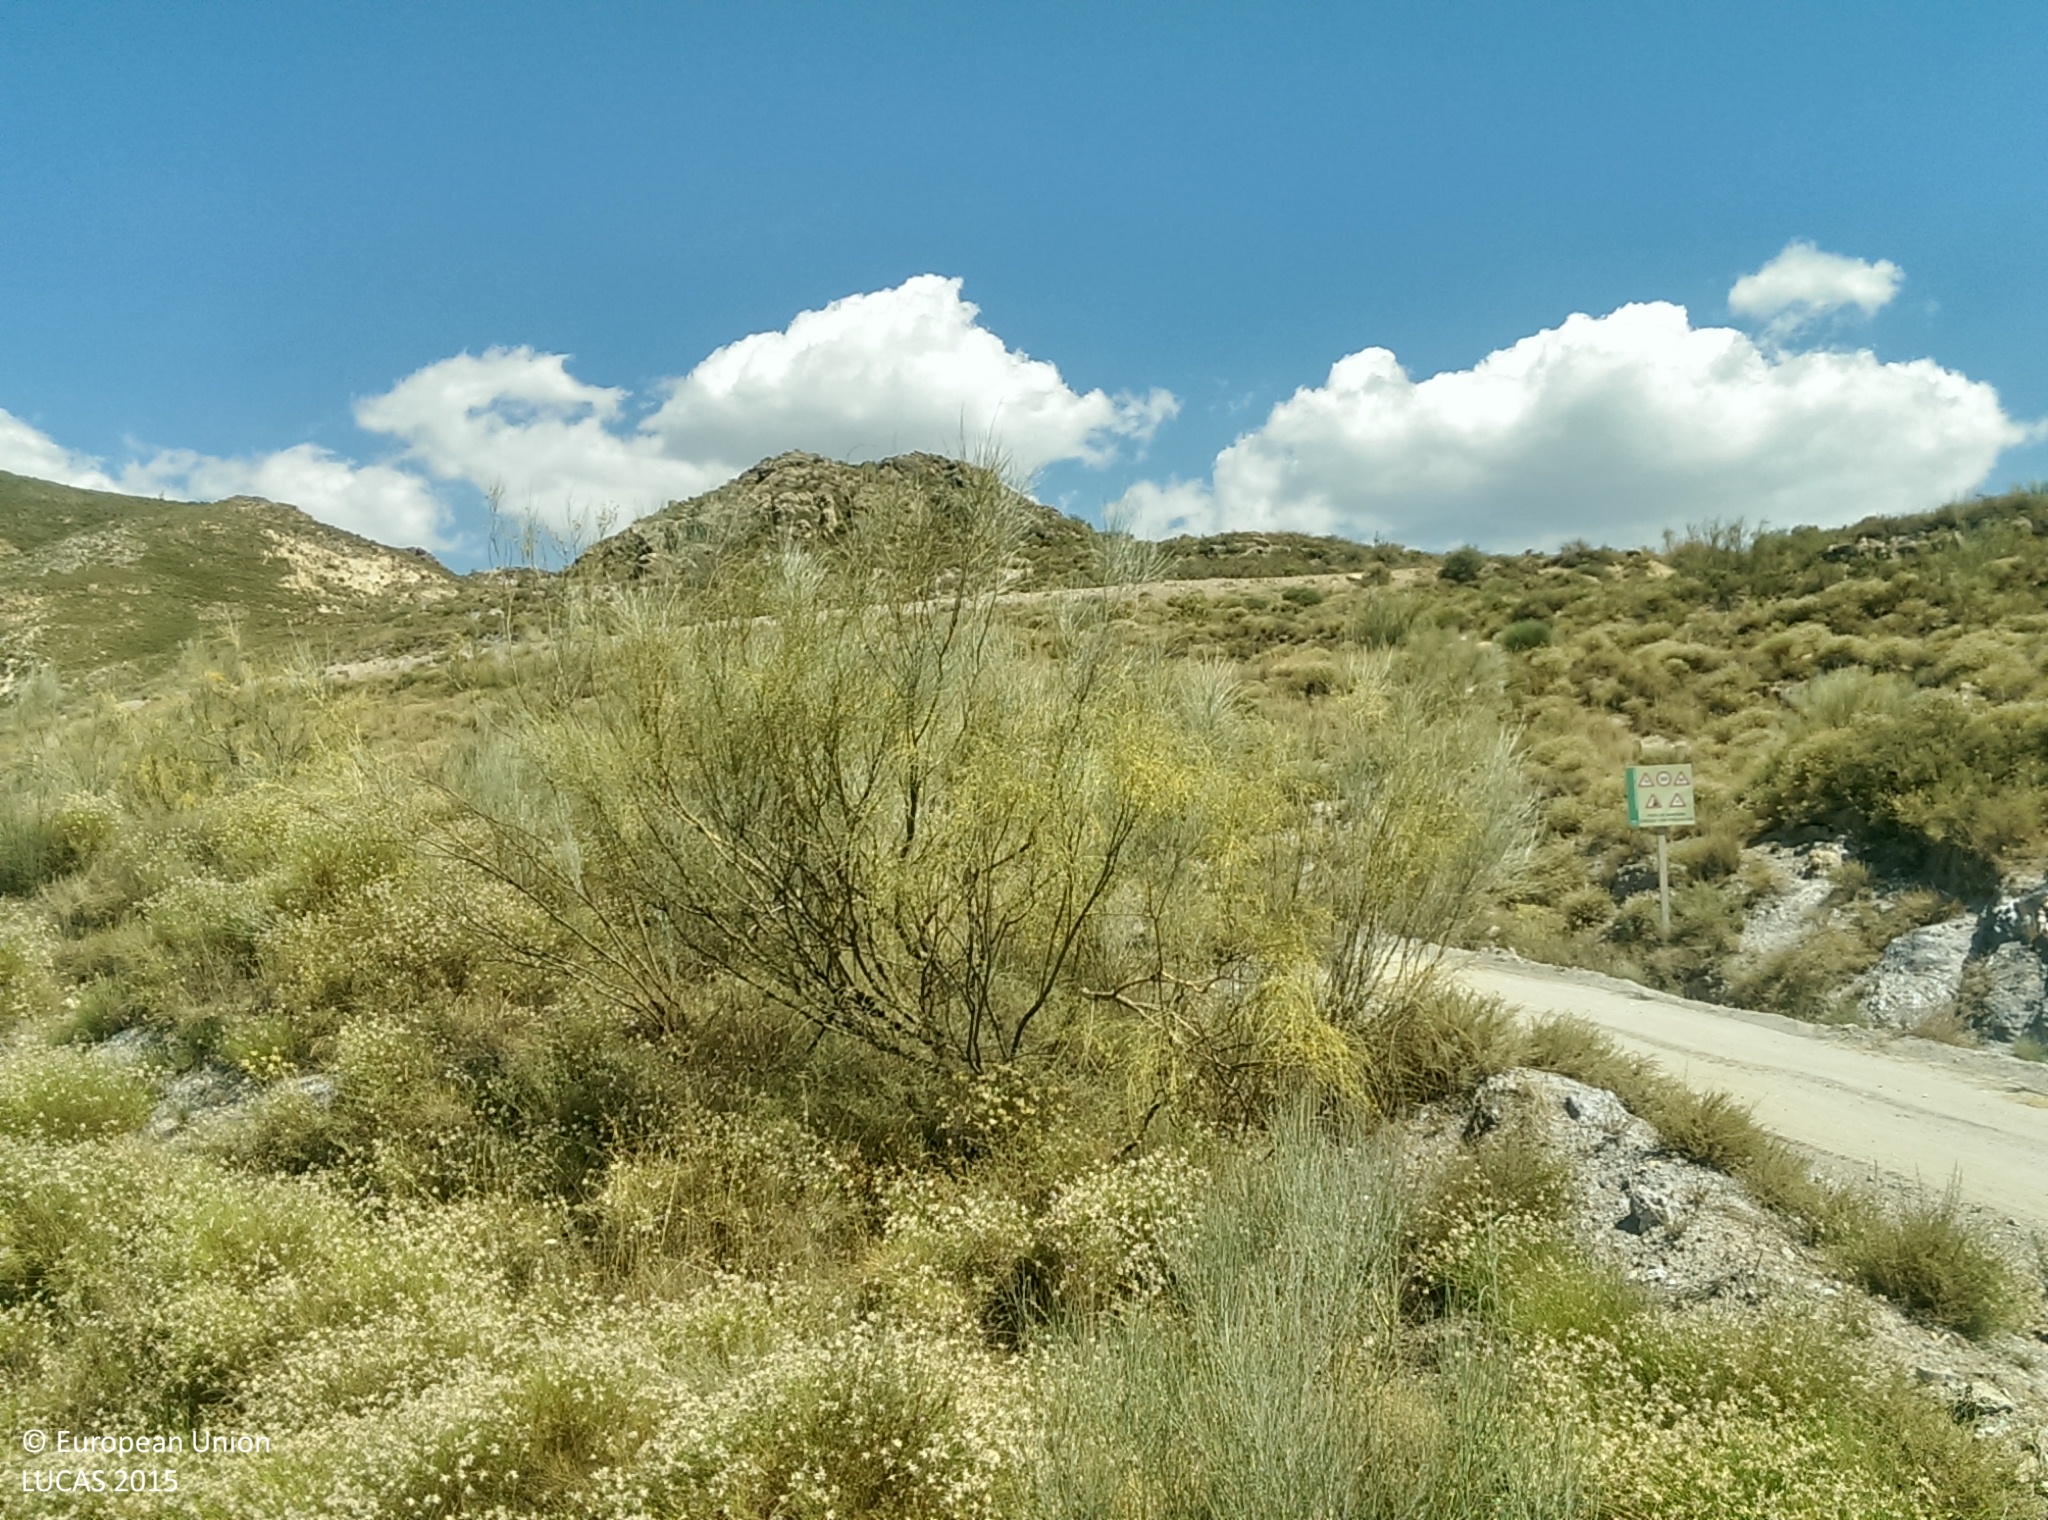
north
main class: Shrubland
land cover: Shrubland without tree cover
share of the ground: > 75 %
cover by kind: shrubs 75 %, herbaceous plants 20 %, unconsolidated bare surface 5 %
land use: Semi-natural and natural areas not in use
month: July
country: ES
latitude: 36.9787
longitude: -3.1369
